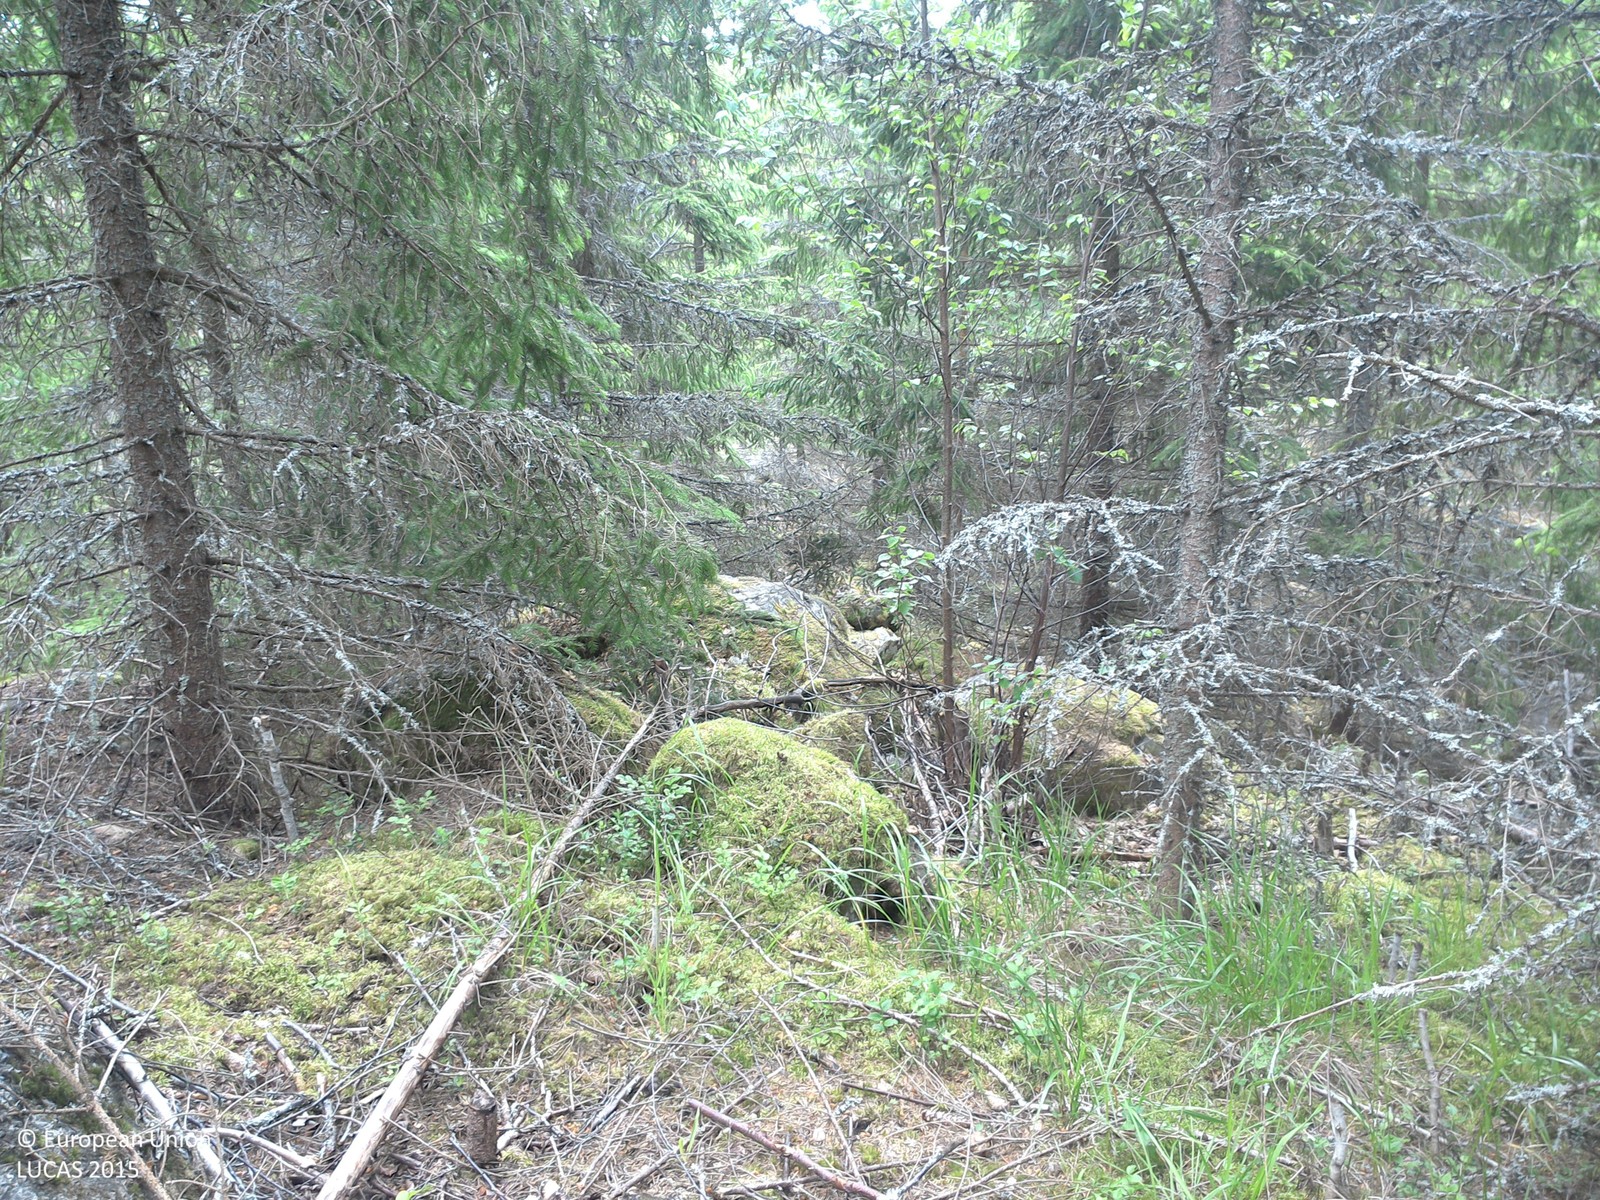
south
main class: Woodland
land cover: Spruce dominated coniferous woodland
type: boreal forest
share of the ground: 50 - 75 %
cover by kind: coniferous forest trees 60 %, lichens and mosses 40 %
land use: Forestry
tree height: > 5 m
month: June
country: SE
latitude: 58.0132
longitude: 16.0050
